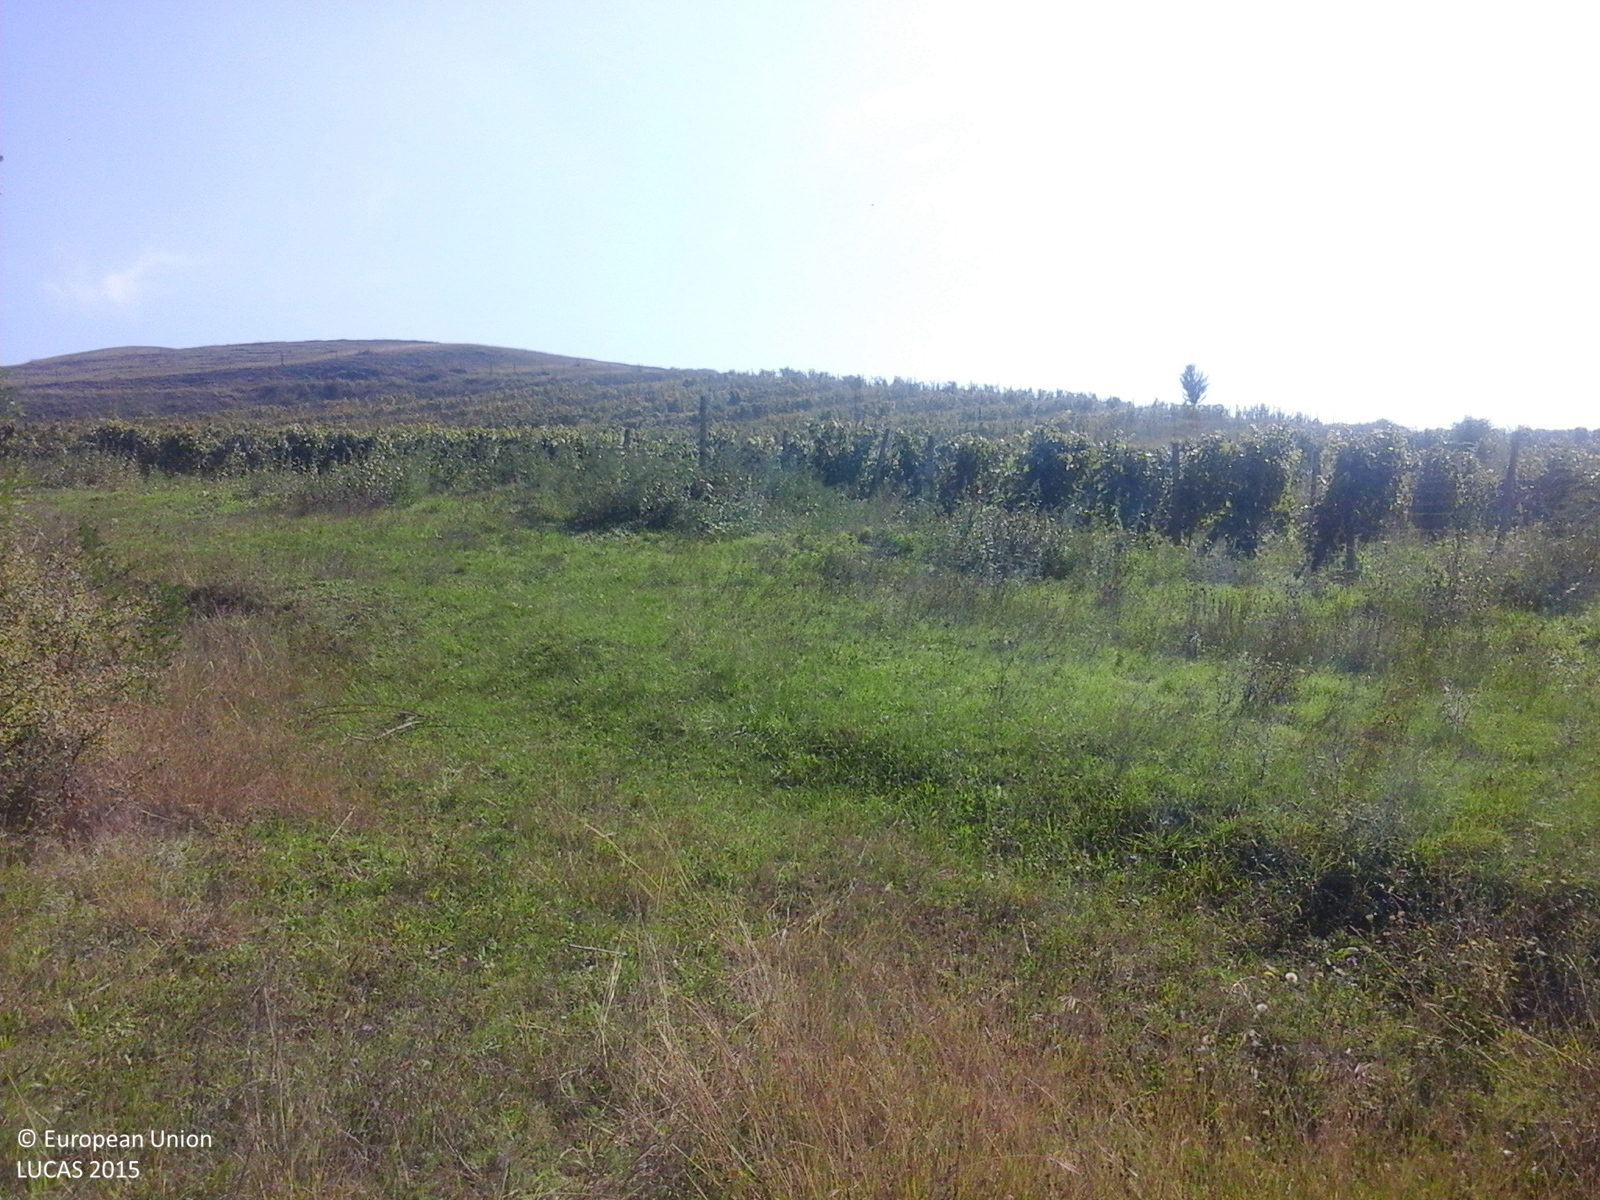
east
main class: Cropland
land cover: Vineyards
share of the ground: > 75 %
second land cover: Grassland without tree/shrub cover
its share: > 75 %
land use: Agriculture (excluding fallow land and kitchen gardens)
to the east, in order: Tracks; Vineyards; Tracks; Grassland without tree/shrub cover; Vineyards; Shrubland with sparse tree cover; Tracks; Shrubland with sparse tree cover; Ditches and canals; Grassland without tree/shrub cover
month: October
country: RO
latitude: 46.2959
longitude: 23.7670
